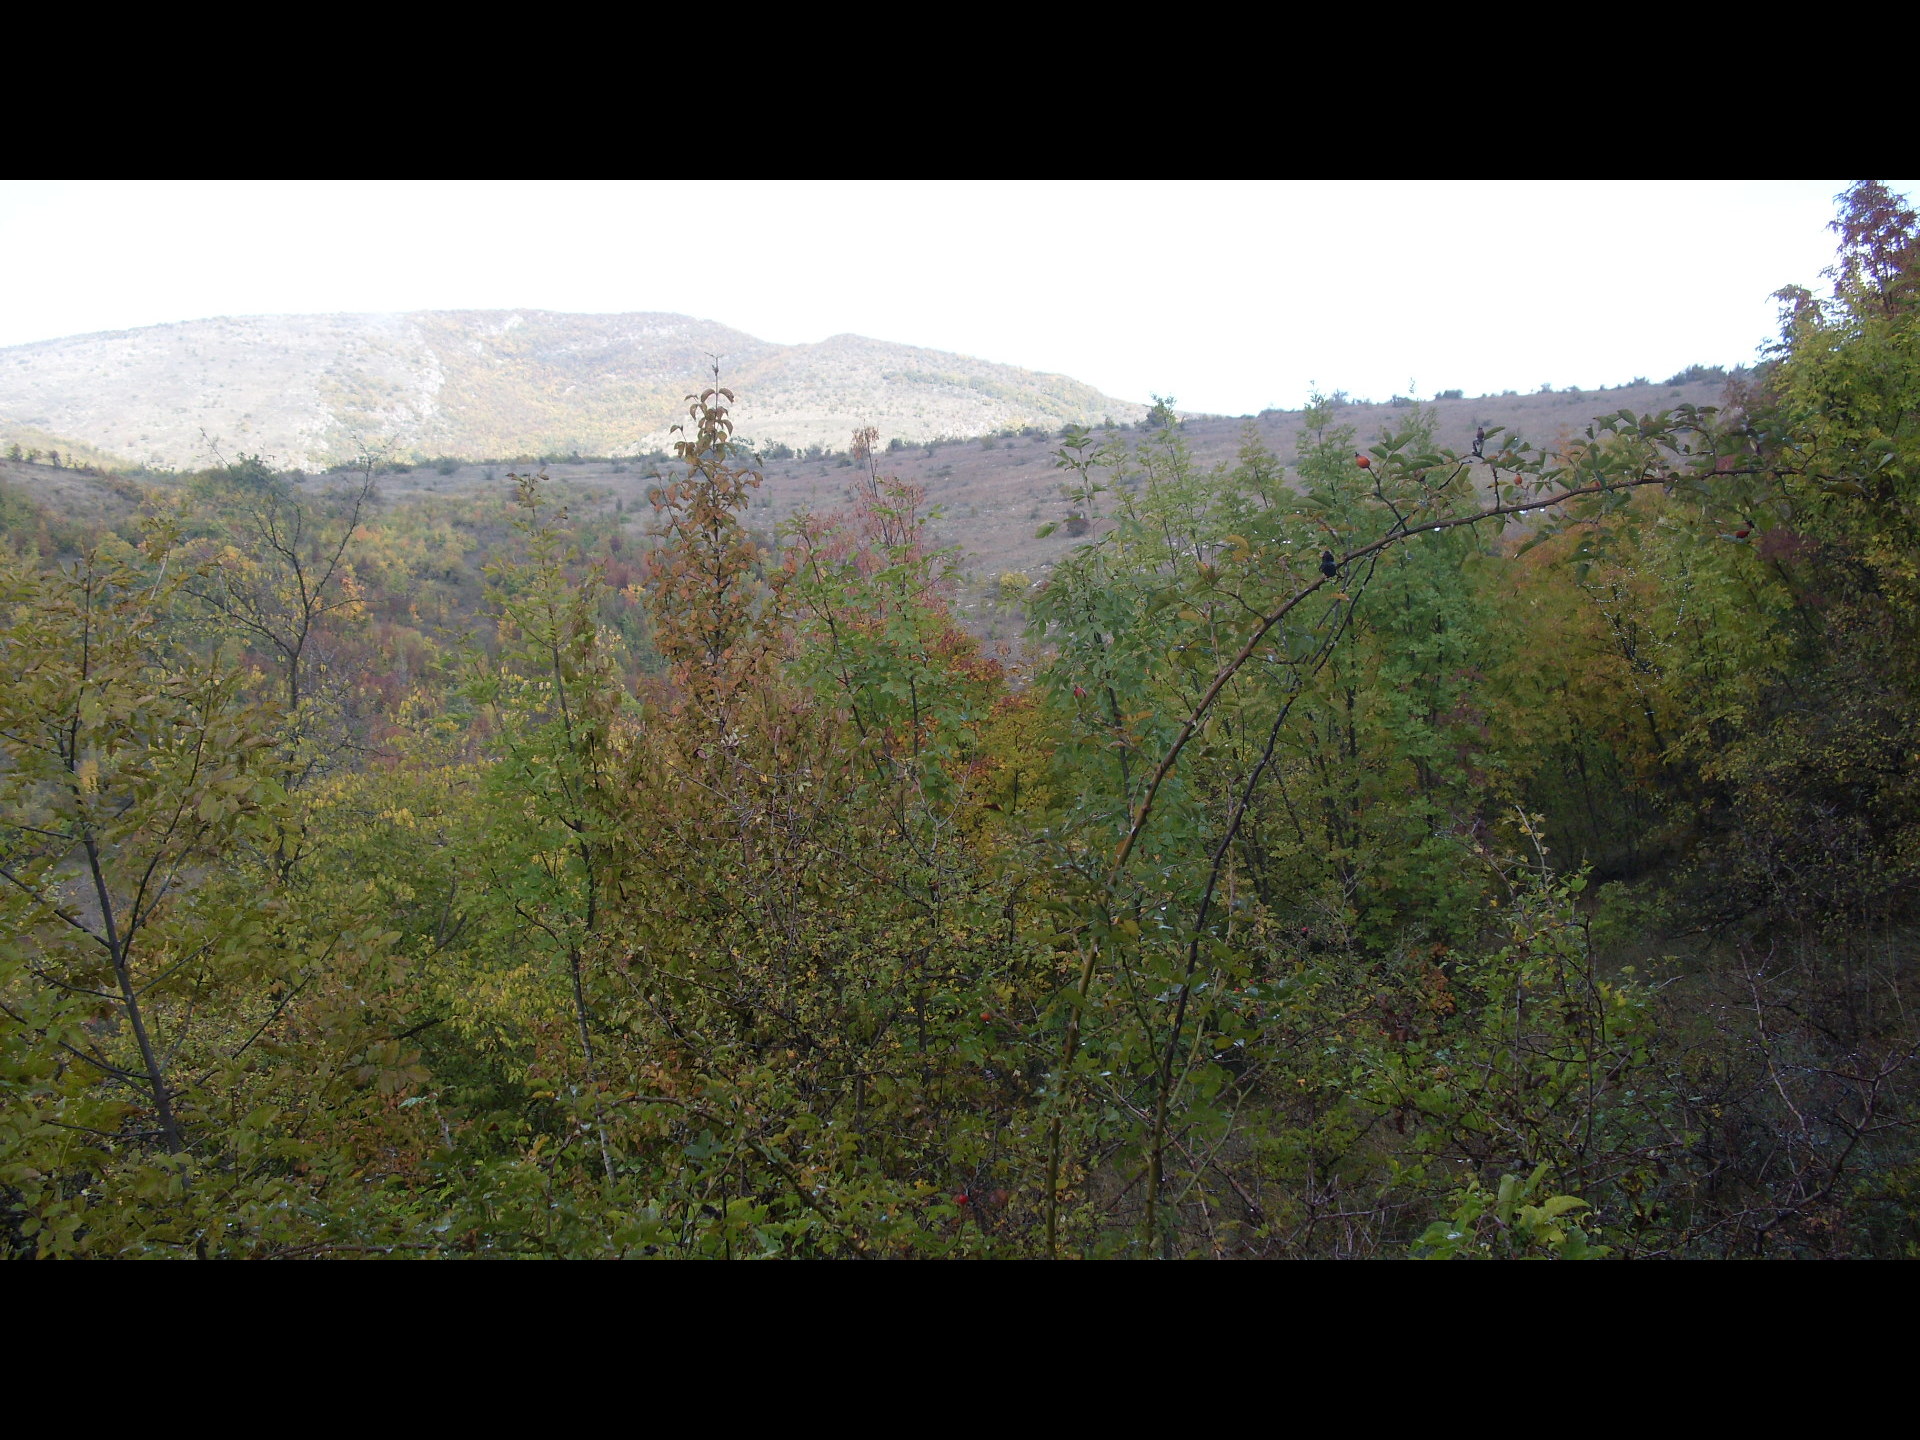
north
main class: Woodland
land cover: Broadleaved woodland
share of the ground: > 75 %
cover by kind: broadleaved forest trees 80 %, shrubs 10 %, herbaceous plants 10 %
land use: Forestry
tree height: < 5 m
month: October
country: BG
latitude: 43.6027
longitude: 22.5567
